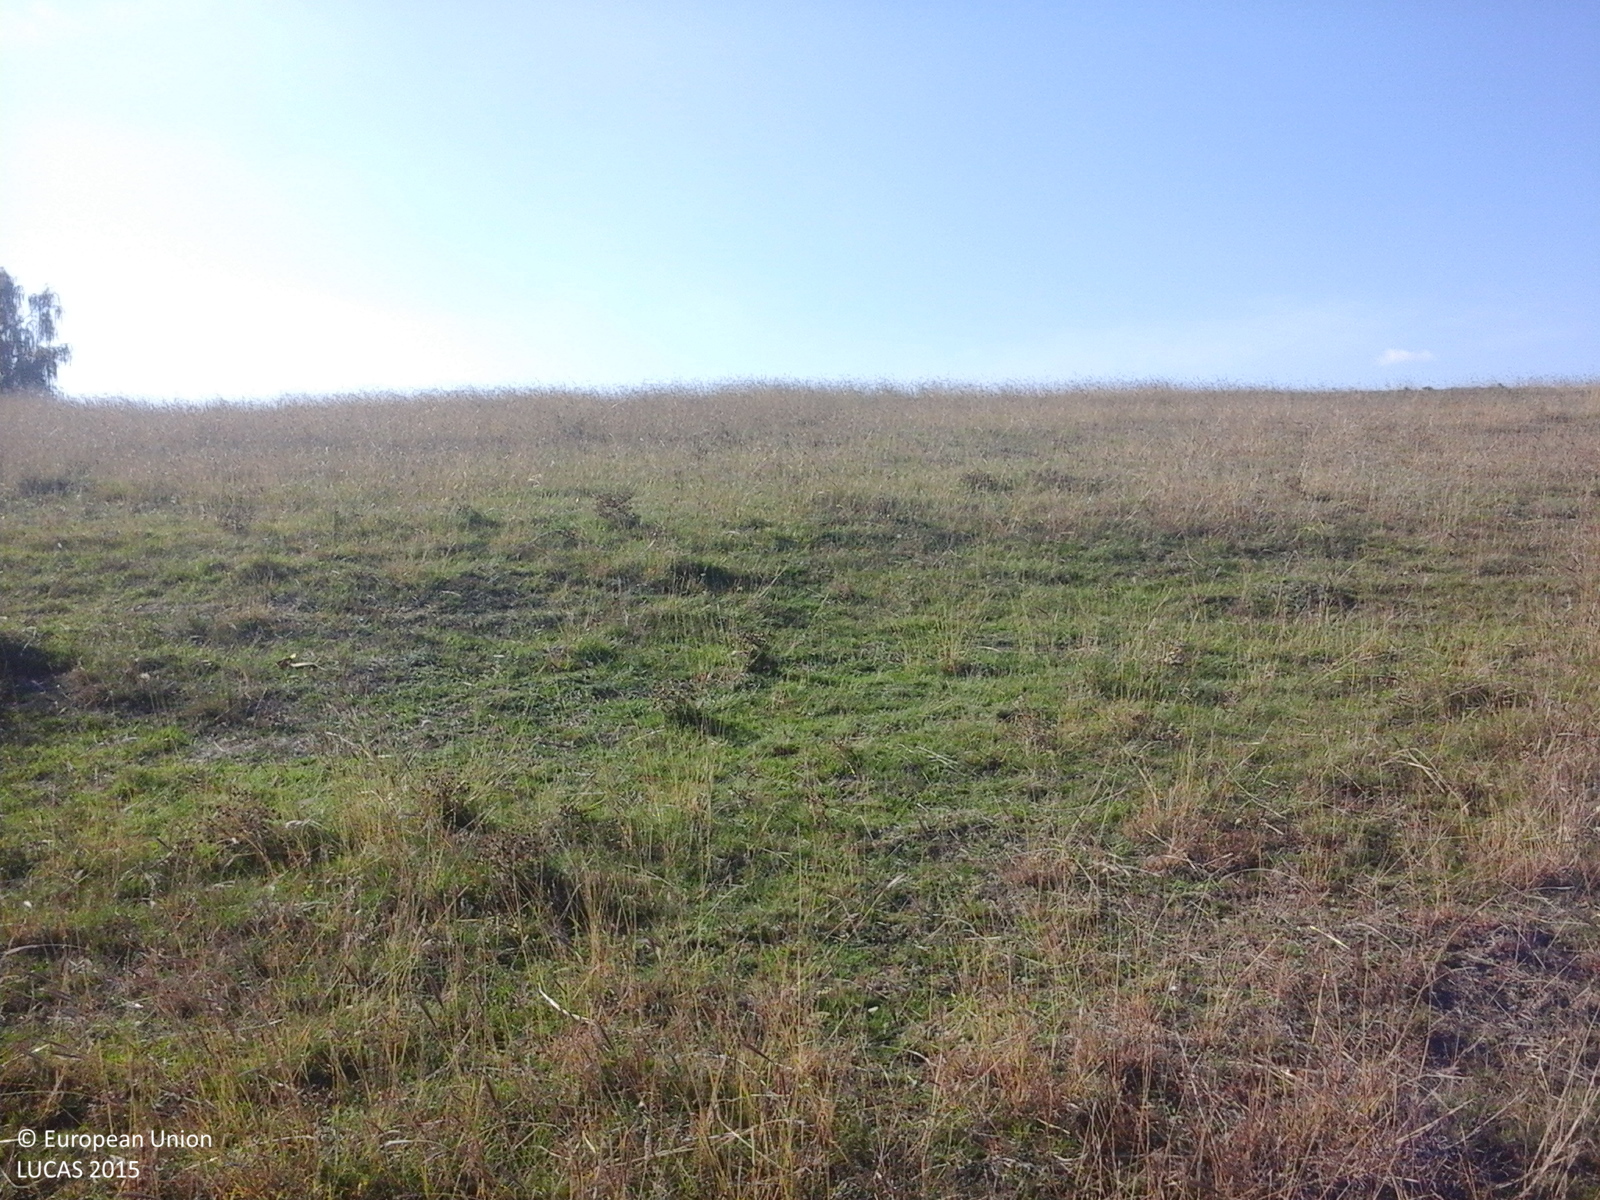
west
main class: Grassland
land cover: Grassland without tree/shrub cover
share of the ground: > 75 %
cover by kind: herbaceous plants 100 %
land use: Agriculture (excluding fallow land and kitchen gardens)
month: October
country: RO
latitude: 46.0912
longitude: 27.0503
